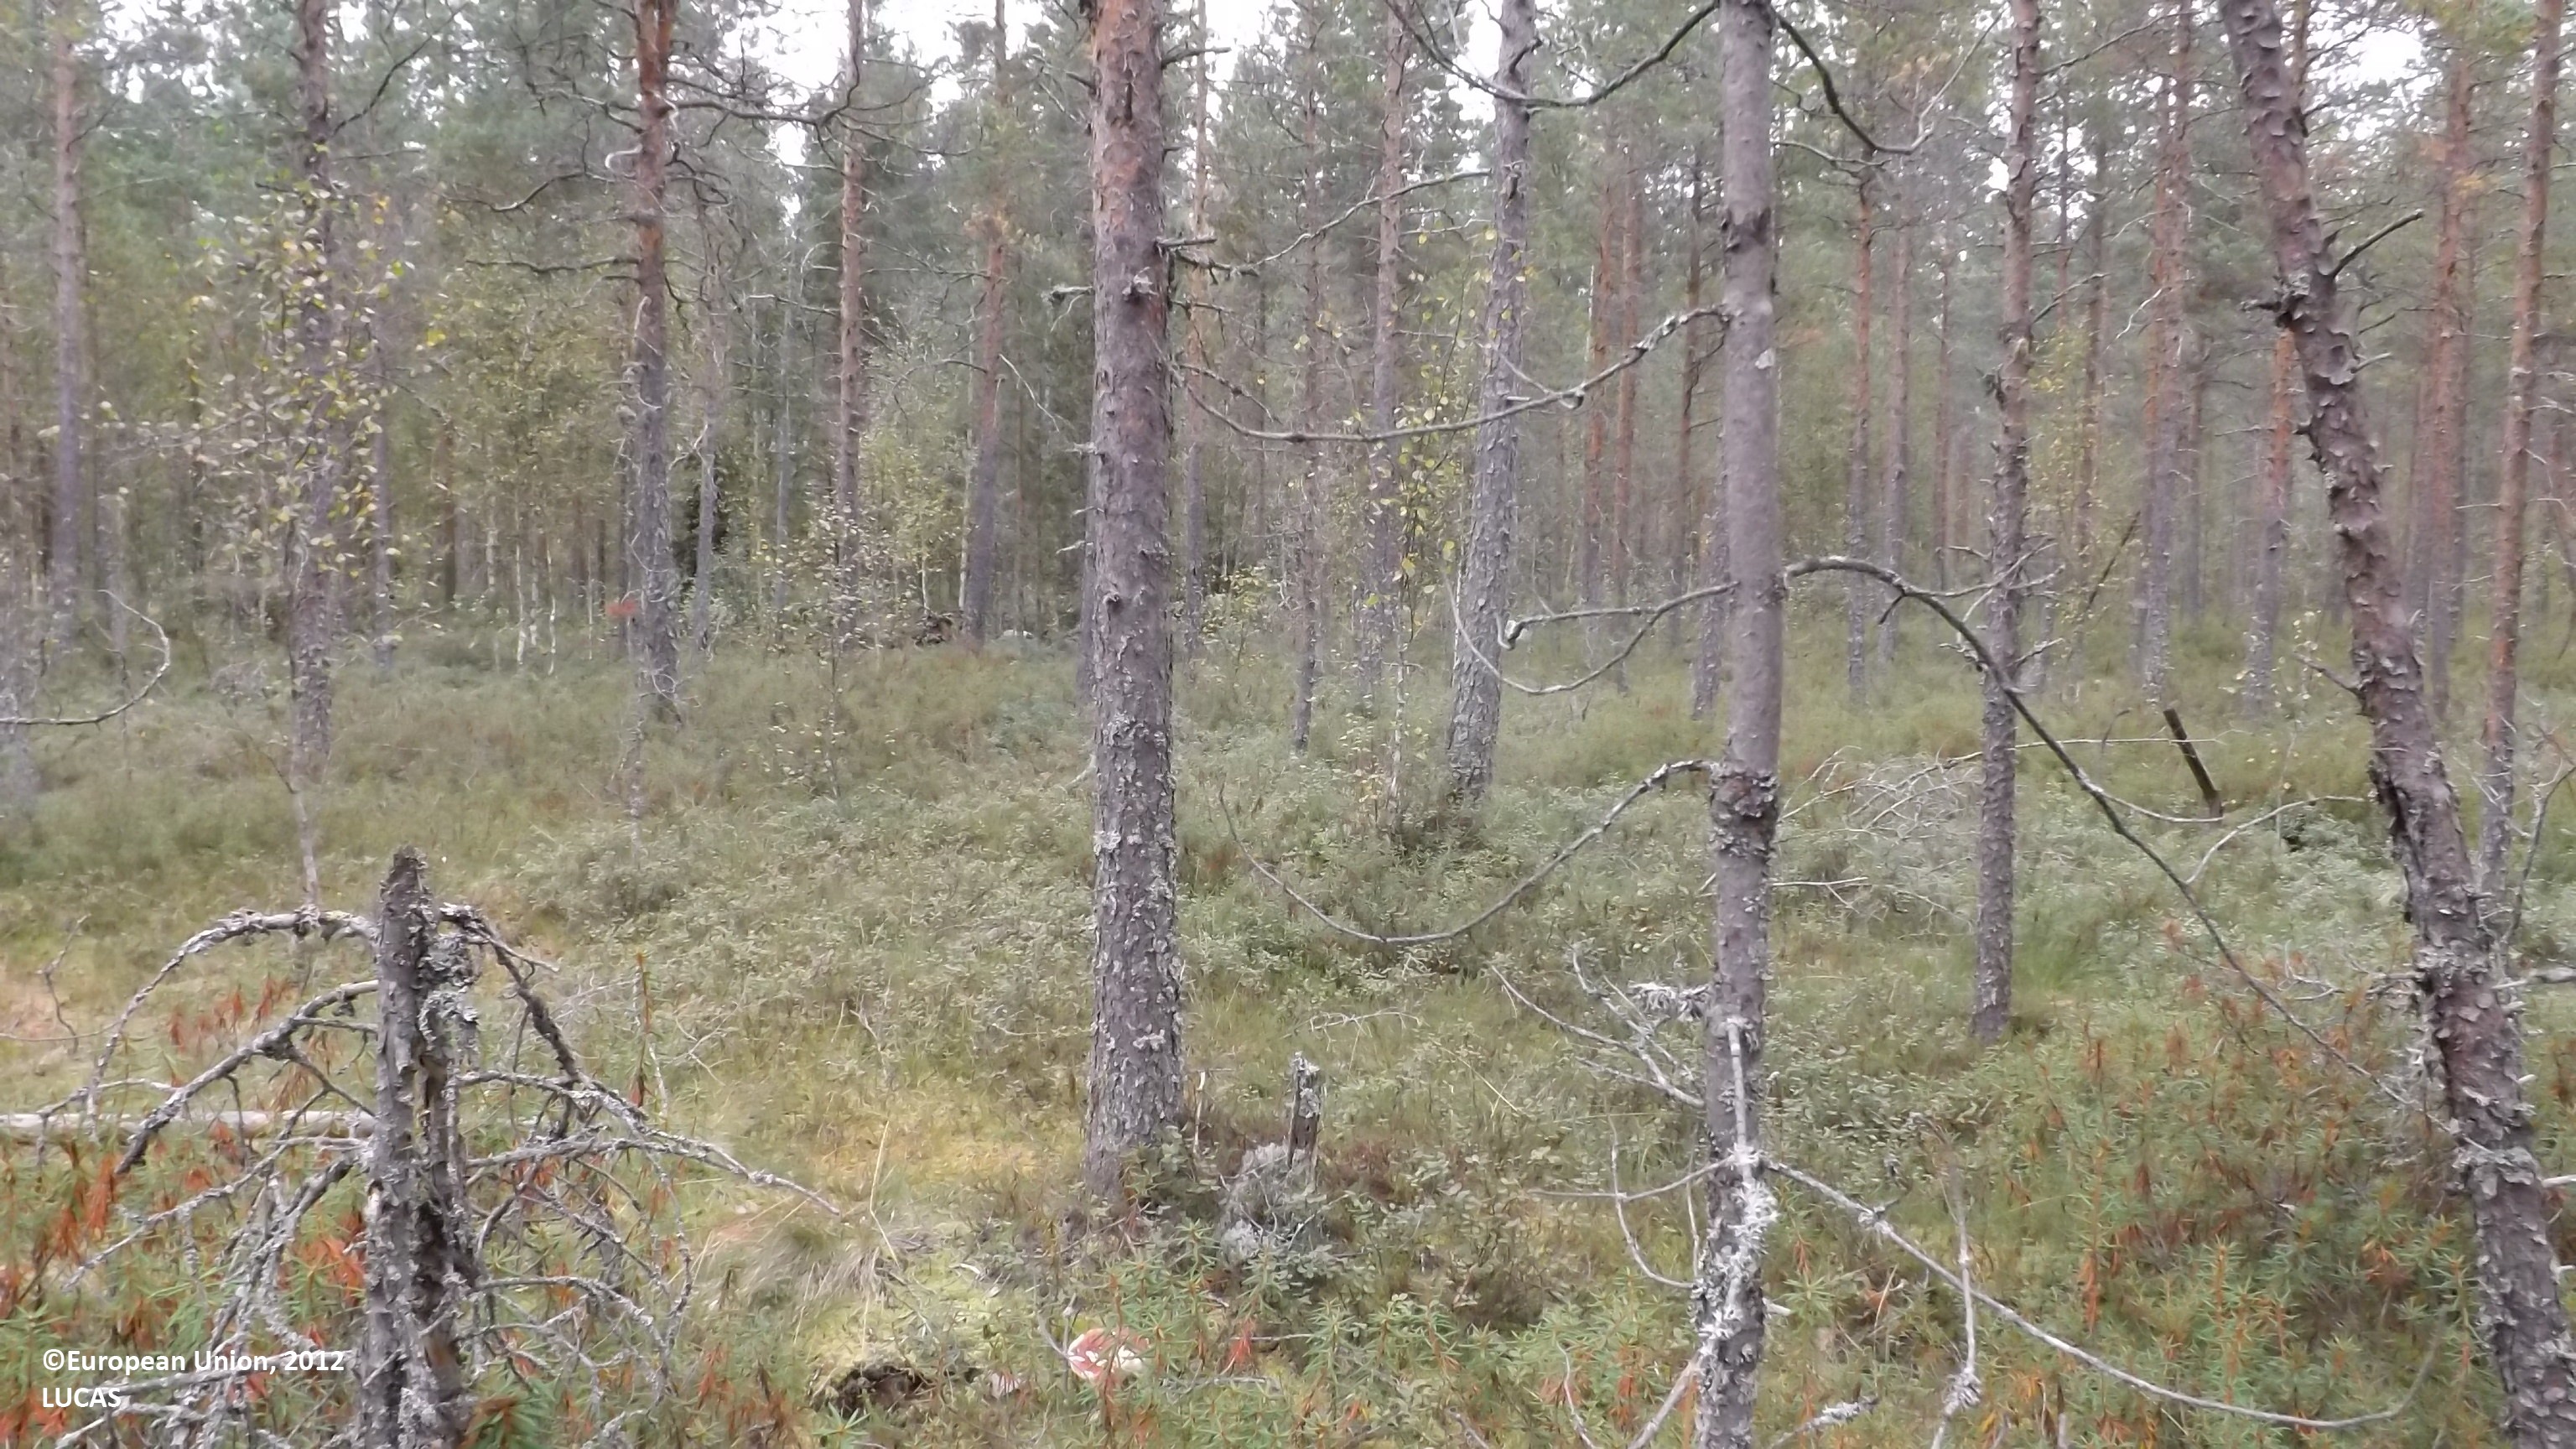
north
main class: Woodland
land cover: Pine dominated coniferous woodland
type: boreal forest
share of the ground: 50 - 75 %
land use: Forestry
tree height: > 5 m
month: August
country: FI
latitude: 63.7525
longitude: 23.8261
